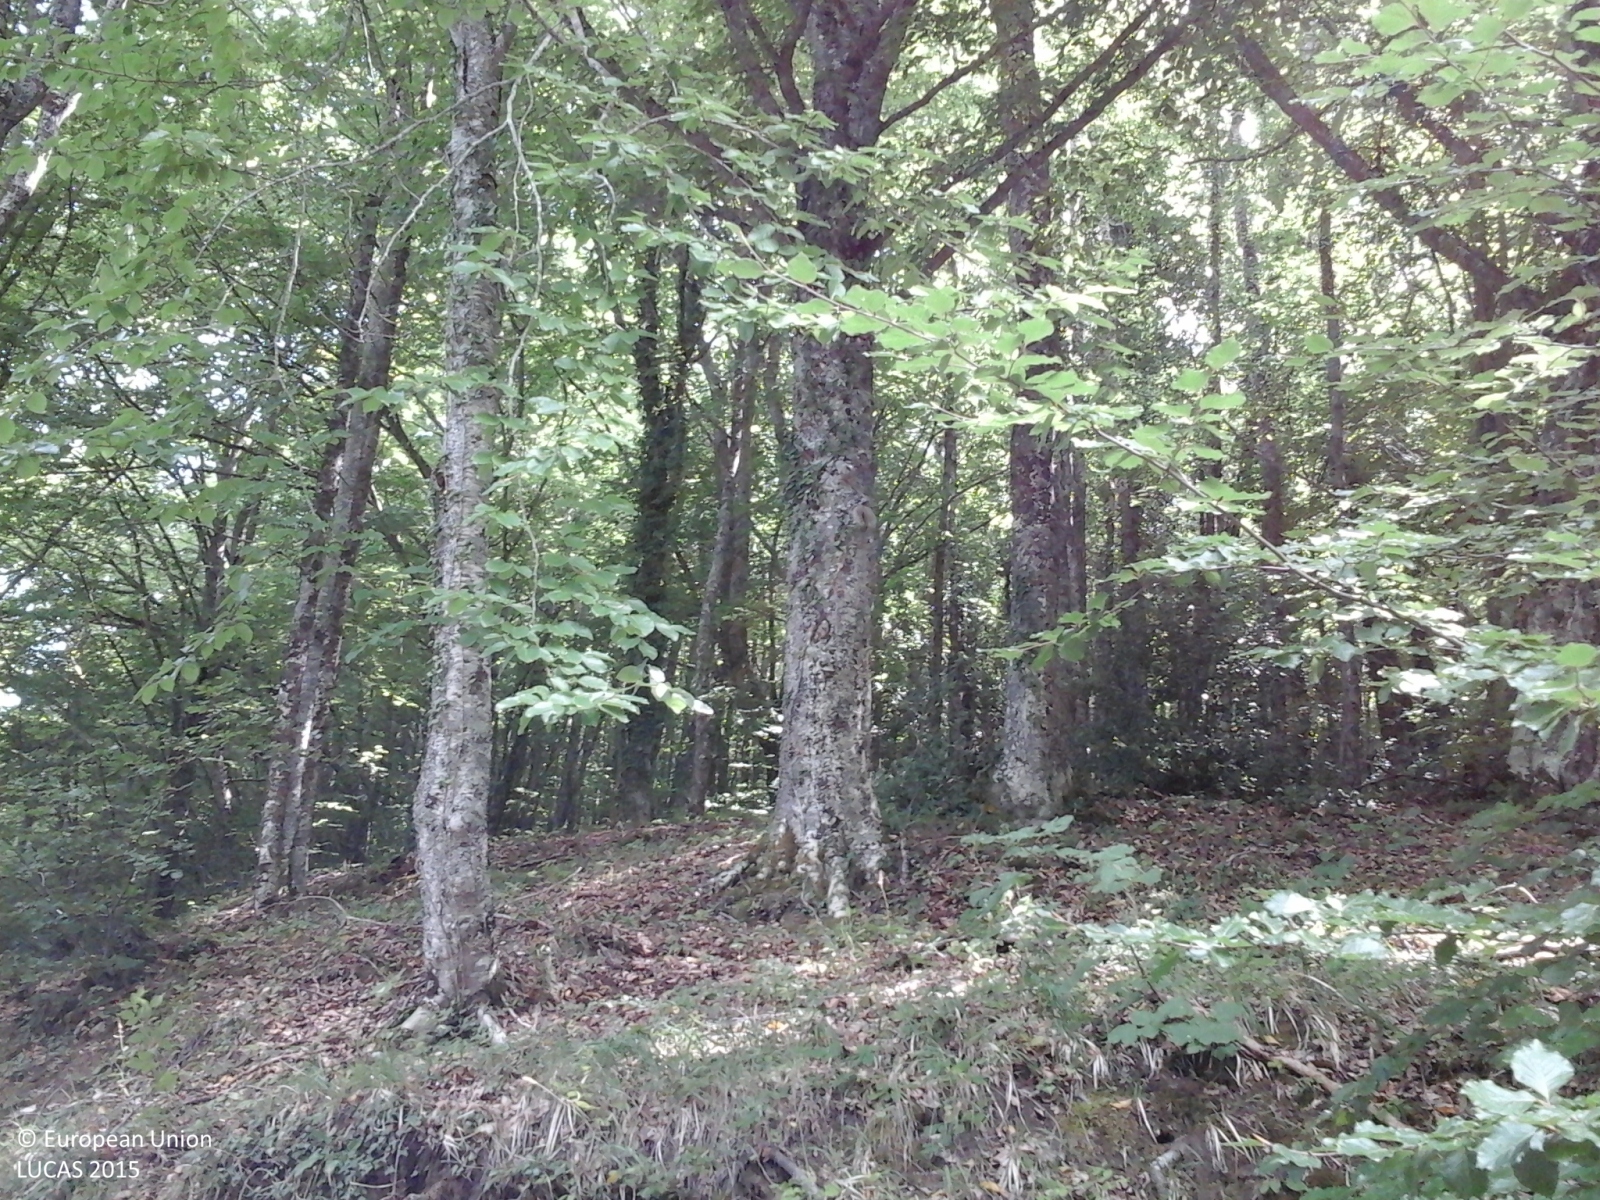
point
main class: Woodland
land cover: Broadleaved woodland
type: mountainous beech forest
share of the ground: > 75 %
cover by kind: broadleaved forest trees 100 %
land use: Forestry
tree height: > 5 m
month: August
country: IT
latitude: 41.8058
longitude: 14.2343
